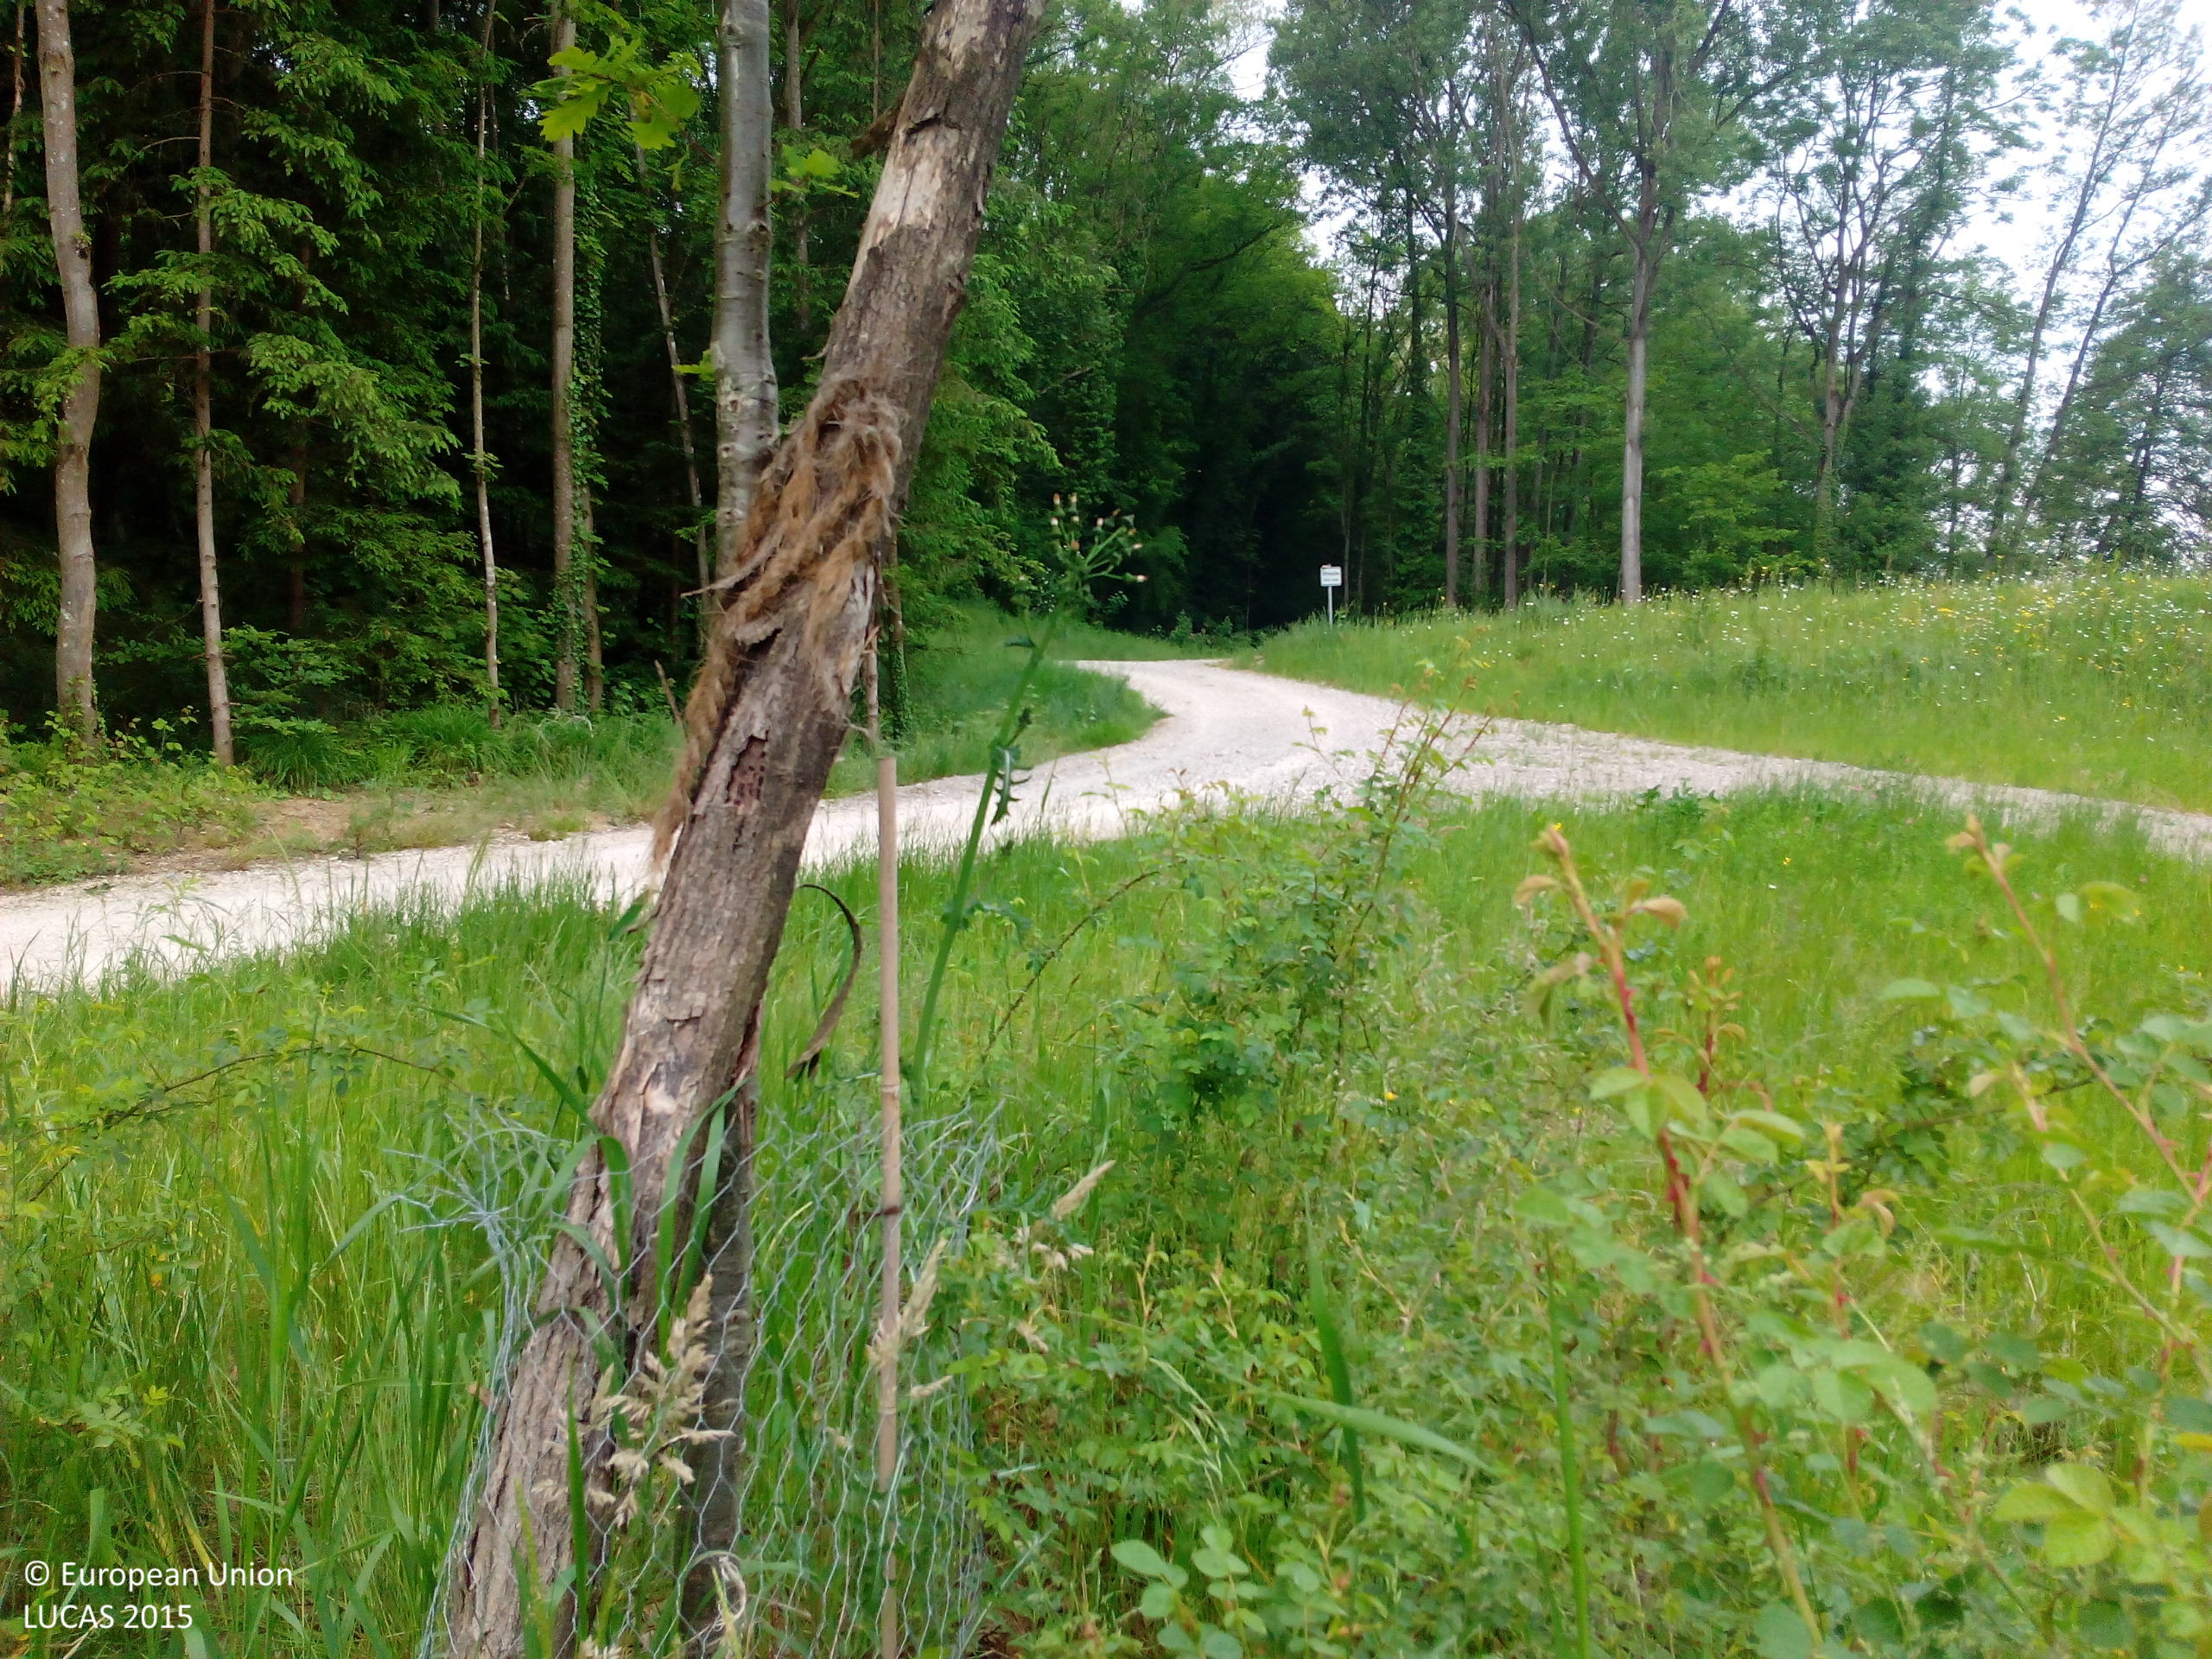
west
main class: Grassland
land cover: Grassland with sparse tree/shrub cover
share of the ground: > 75 %
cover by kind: herbaceous plants 90 %, broadleaved forest trees 5 %, shrubs 5 %
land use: Semi-natural and natural areas not in use
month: May
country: DE
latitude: 47.7470
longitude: 7.5873
